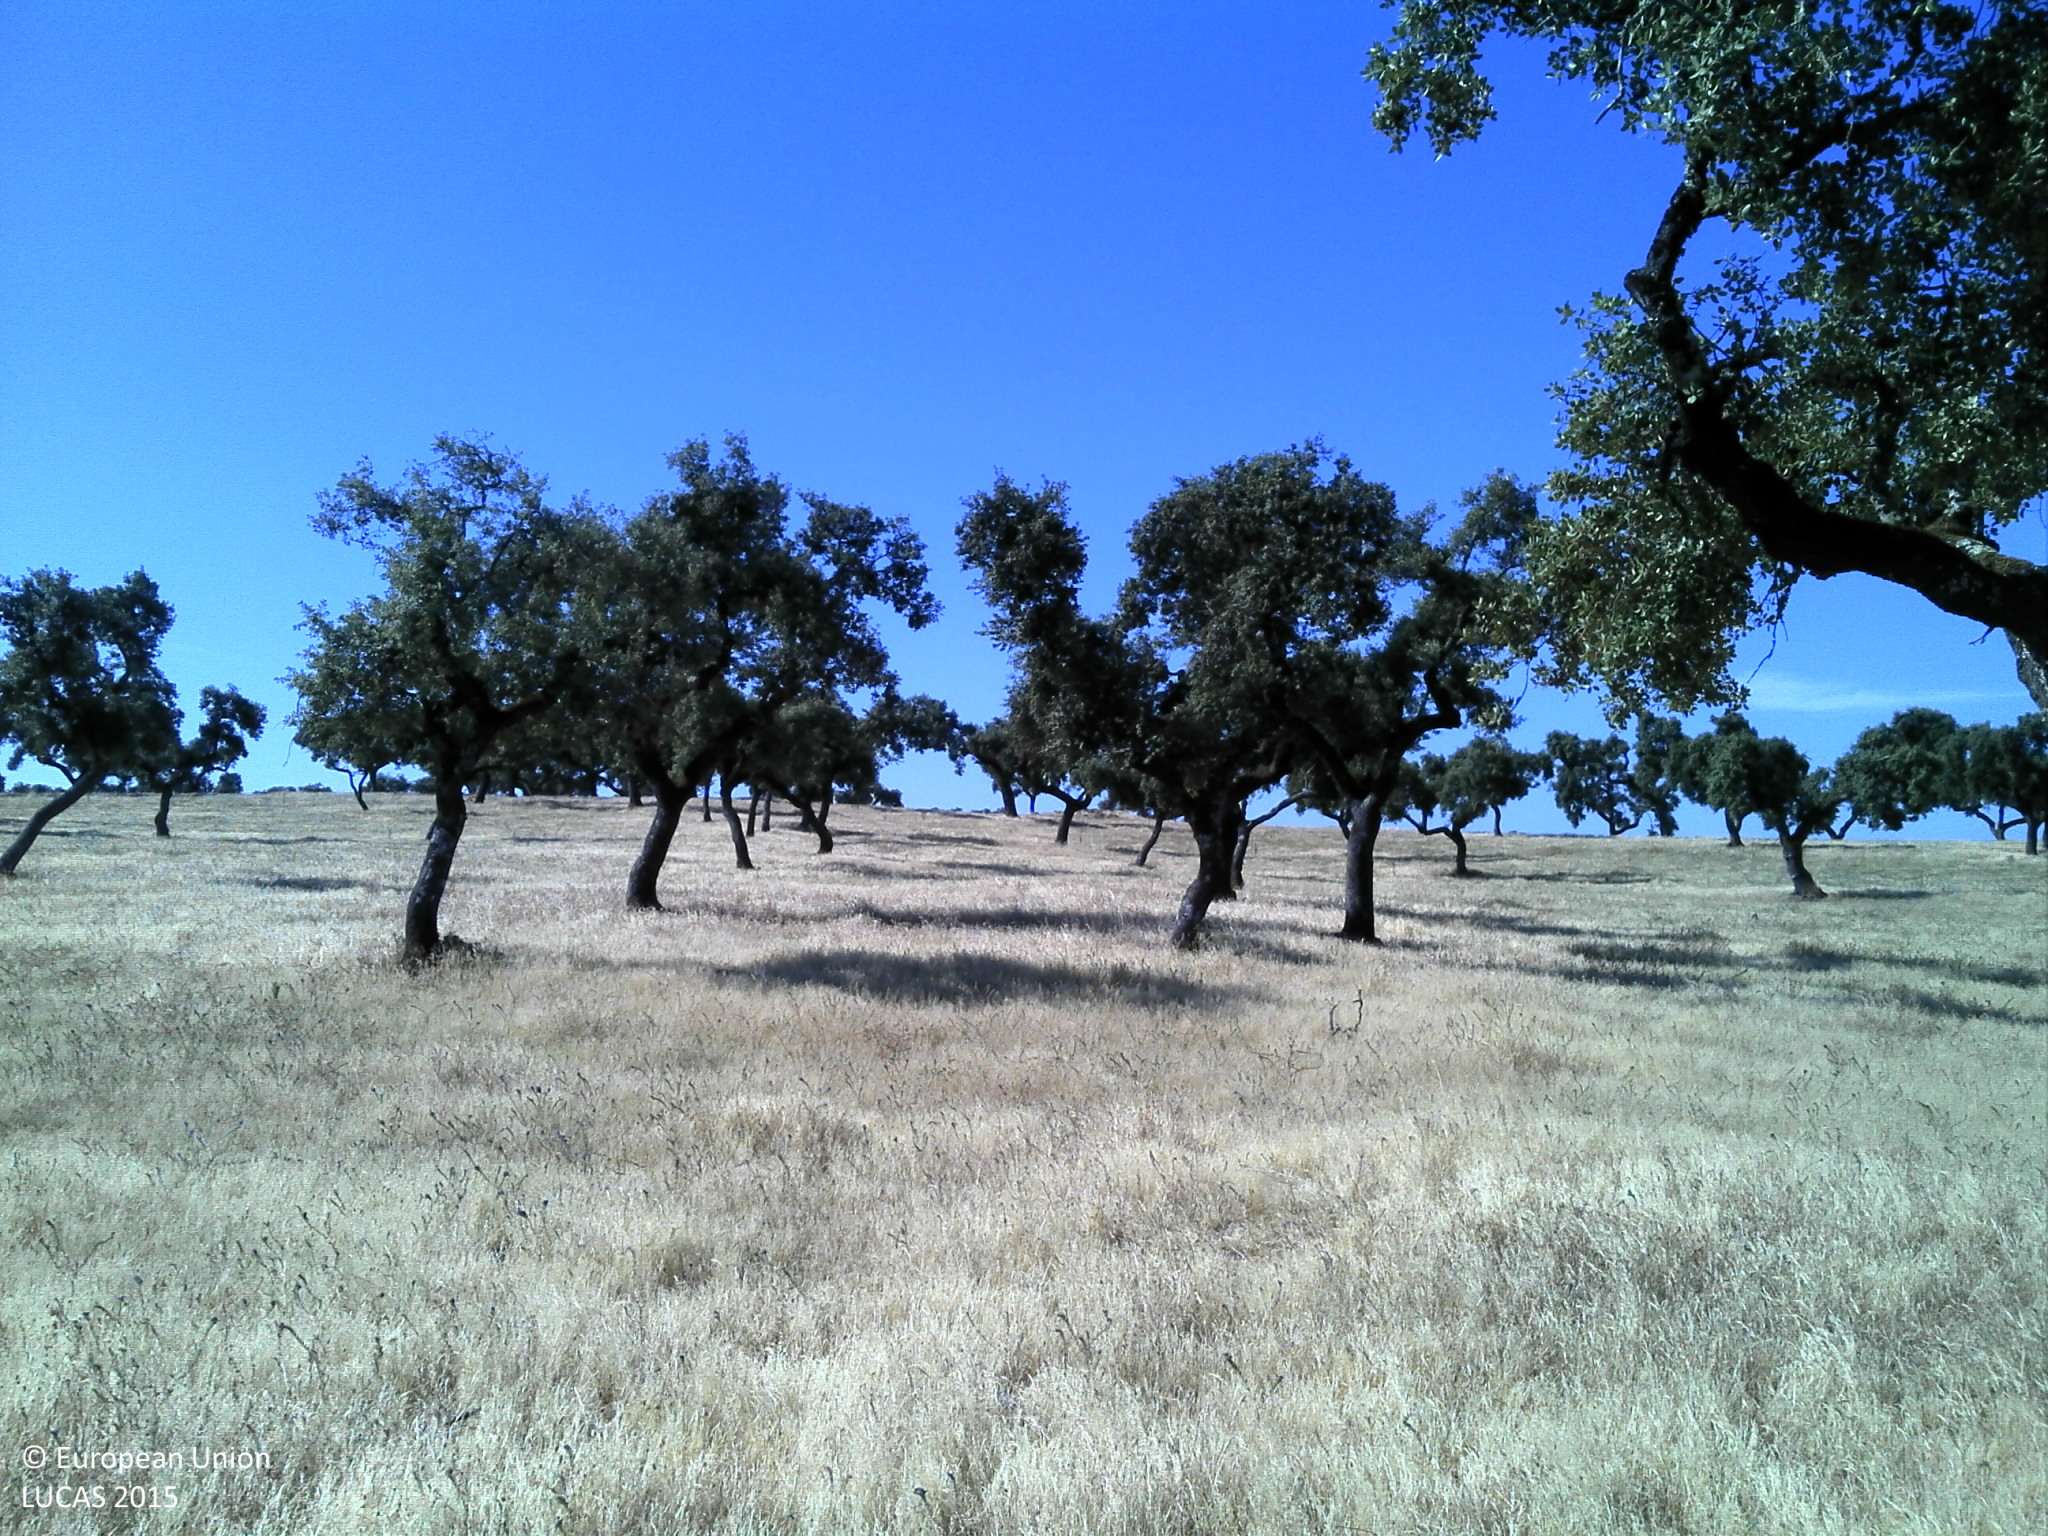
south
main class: Woodland
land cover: Broadleaved woodland
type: broadleaved evergreen forest
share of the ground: 25 - 50 %
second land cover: Grassland without tree/shrub cover
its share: 50 - 75 %
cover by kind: herbaceous plants 50 %, broadleaved forest trees 40 %, unconsolidated bare surface 10 %
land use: Forestry
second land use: Agriculture (excluding fallow land and kitchen gardens)
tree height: > 5 m
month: June
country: PT
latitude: 38.7704
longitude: -8.2012
